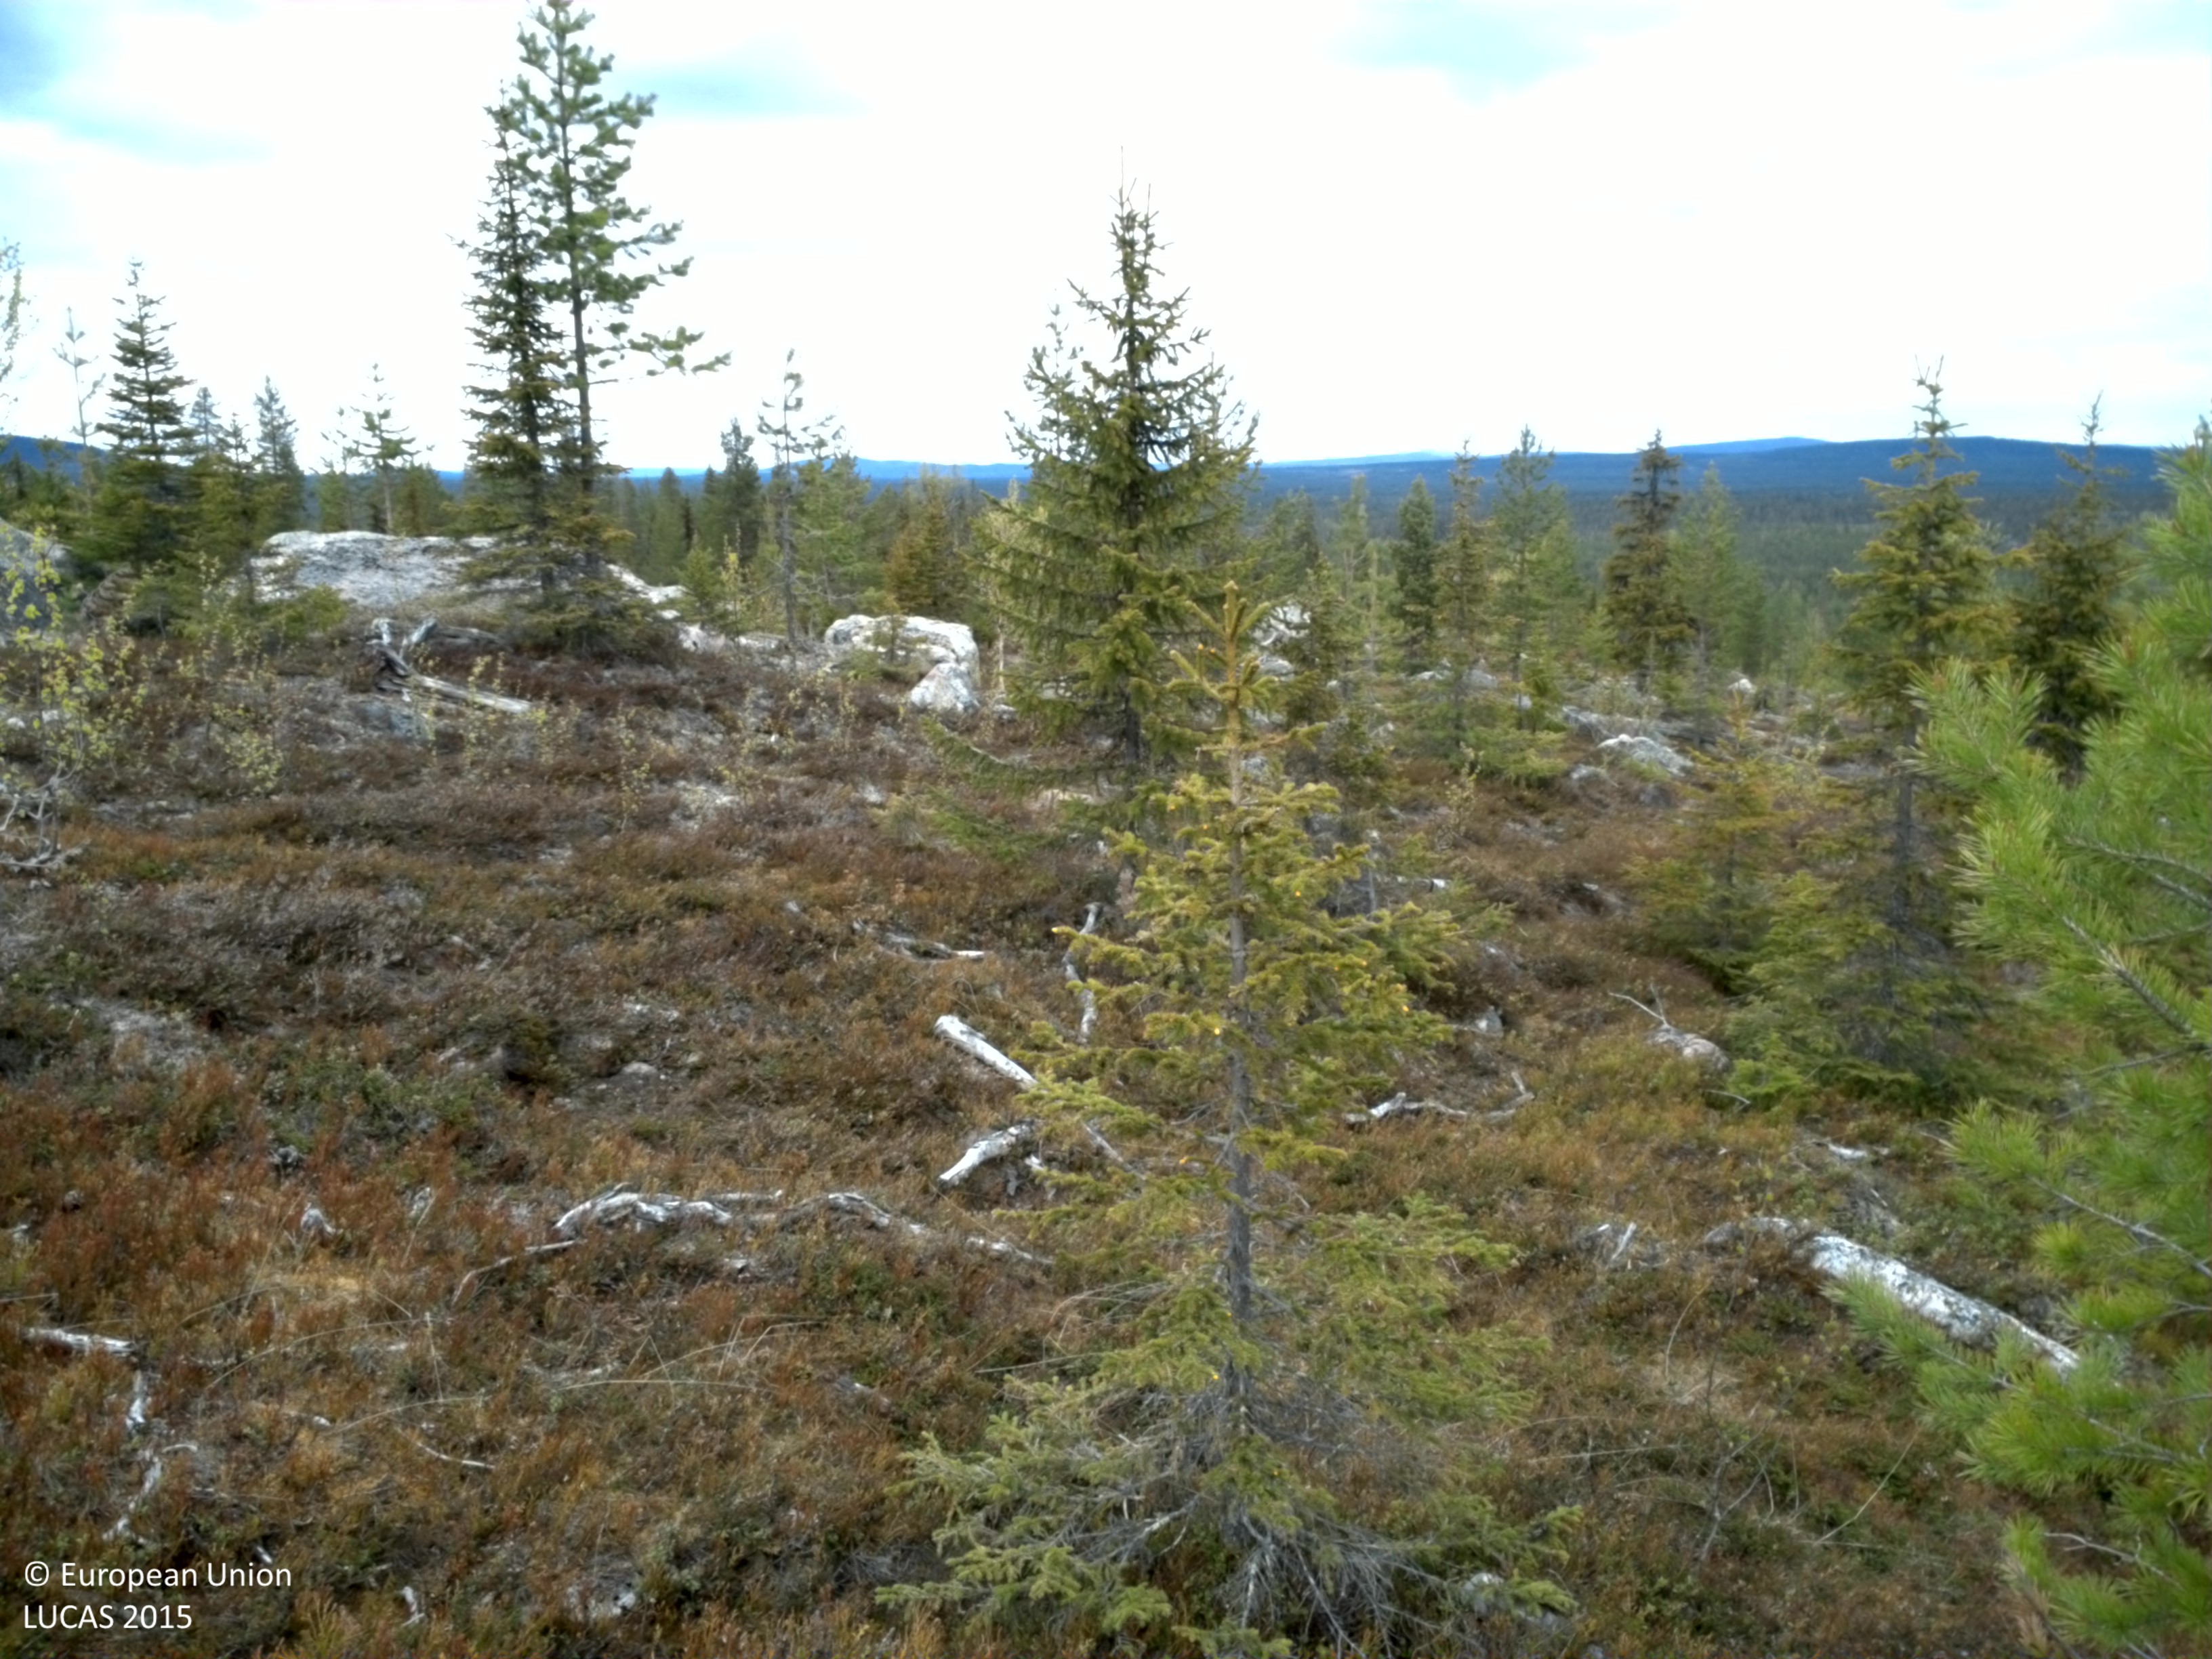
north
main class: Woodland
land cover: Spruce dominated mixed woodland
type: boreal forest
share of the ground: 10 - 25 %
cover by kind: shrubs 65 %, coniferous forest trees 15 %, consolidated bare surface 10 %, broadleaved forest trees 5 %, lichens and mosses 5 %
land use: Forestry
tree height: < 5 m
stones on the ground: > 50 %
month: June
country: SE
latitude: 66.0555
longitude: 18.6333
